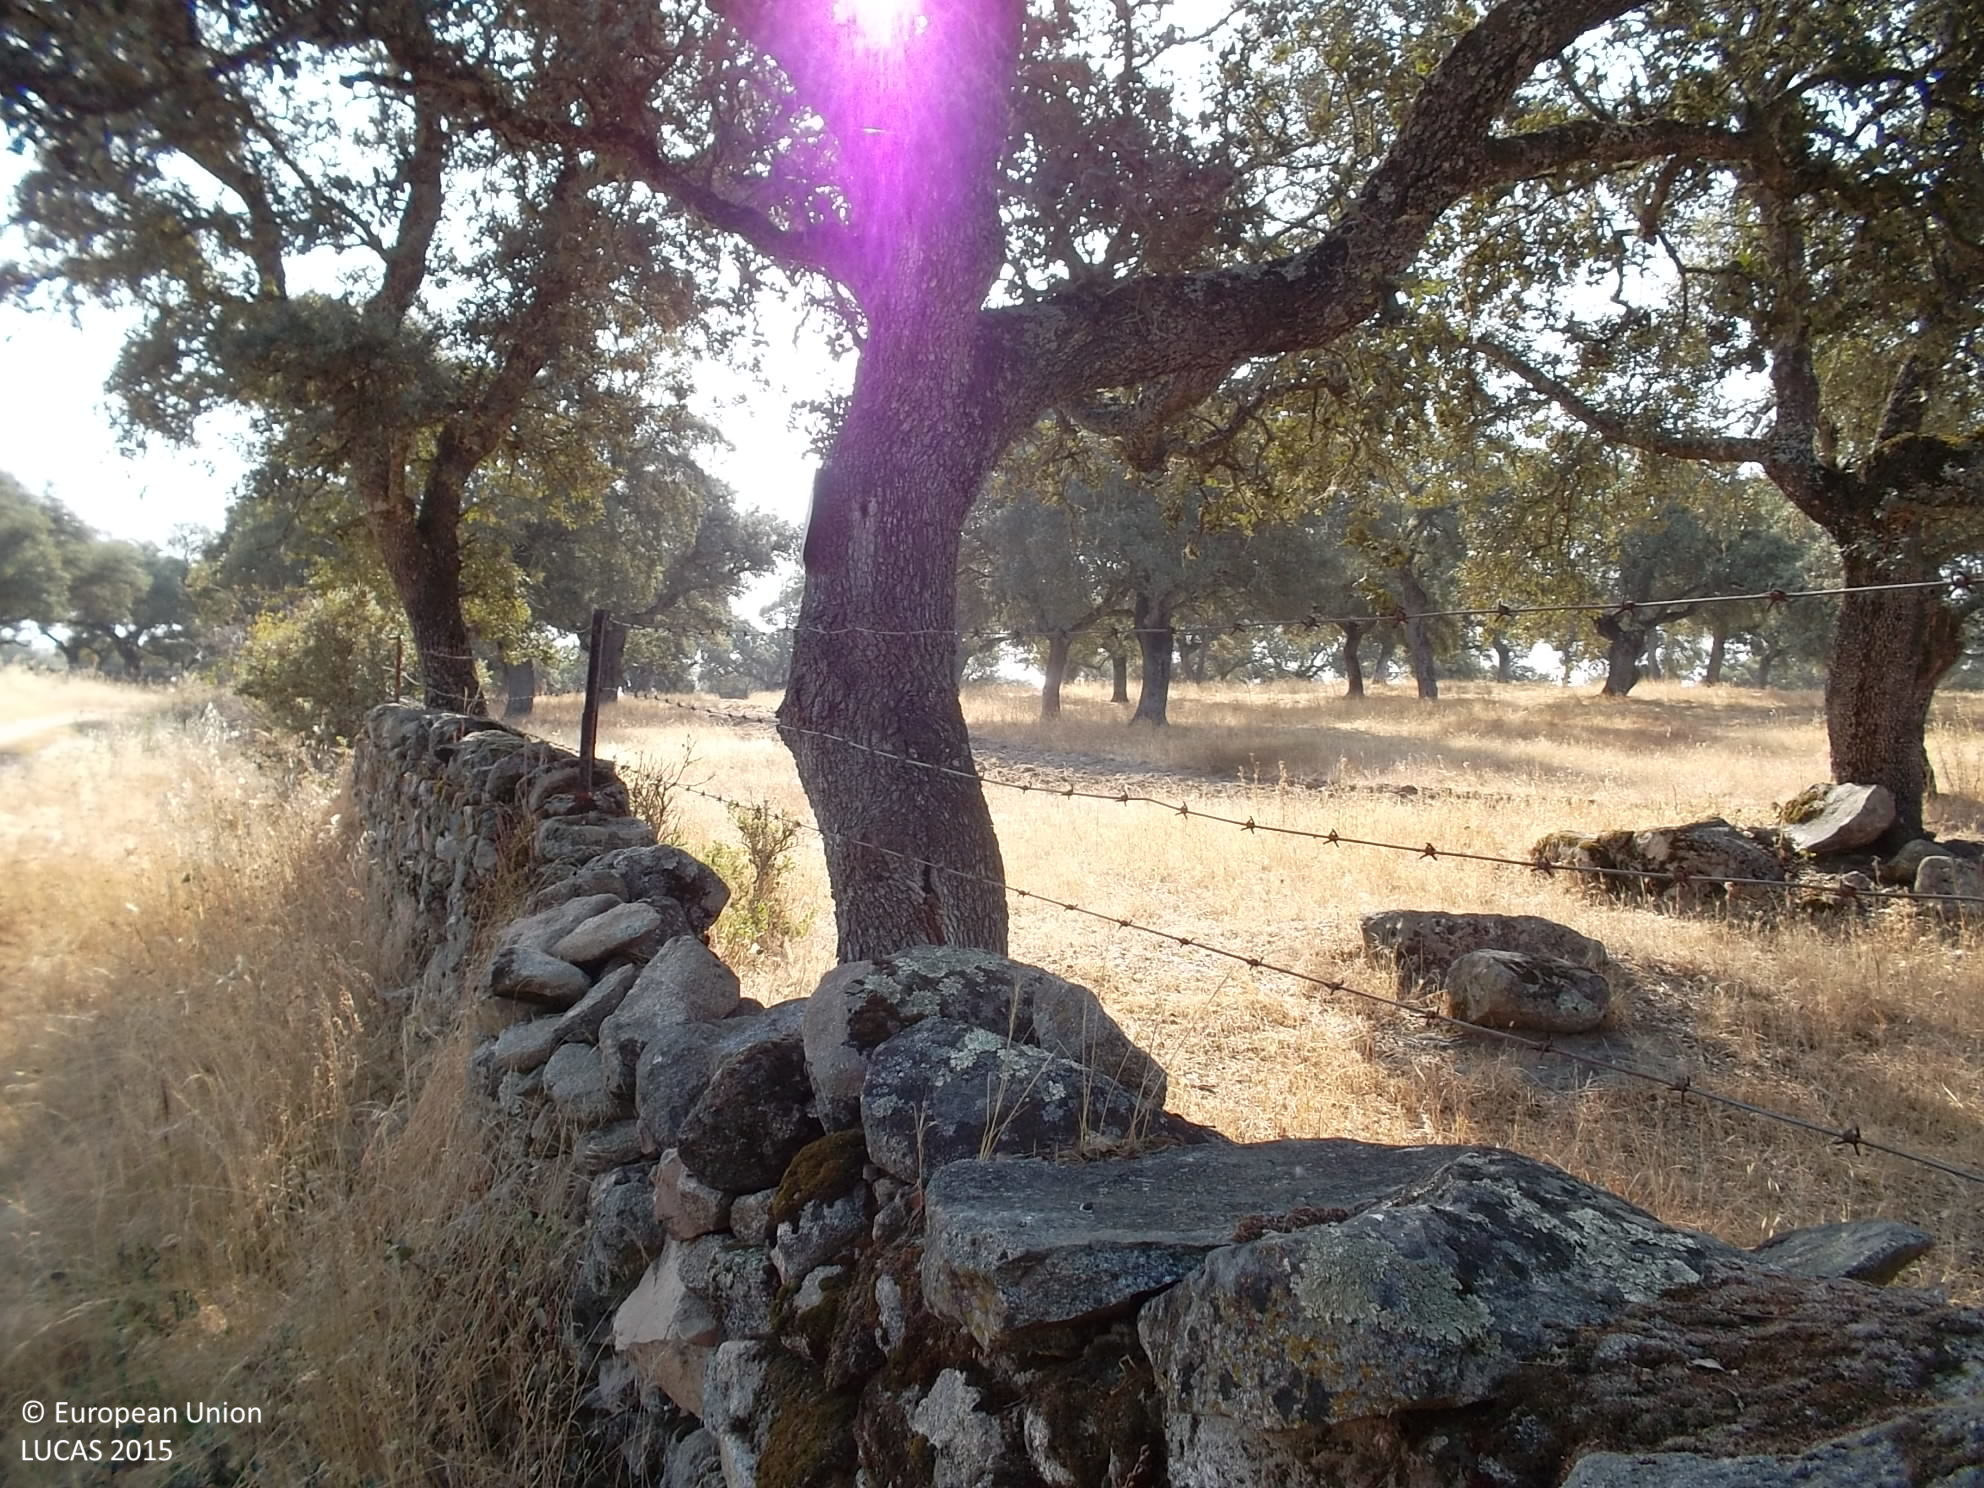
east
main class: Woodland
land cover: Broadleaved woodland
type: broadleaved evergreen forest
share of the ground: 25 - 50 %
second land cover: Grassland without tree/shrub cover
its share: > 75 %
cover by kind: herbaceous plants 70 %, broadleaved forest trees 30 %
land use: Forestry
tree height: > 5 m
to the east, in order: Broadleaved woodland; Grassland without tree/shrub cover; Fences; Broadleaved woodland
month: July
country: ES
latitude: 38.2883
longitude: -4.7114
